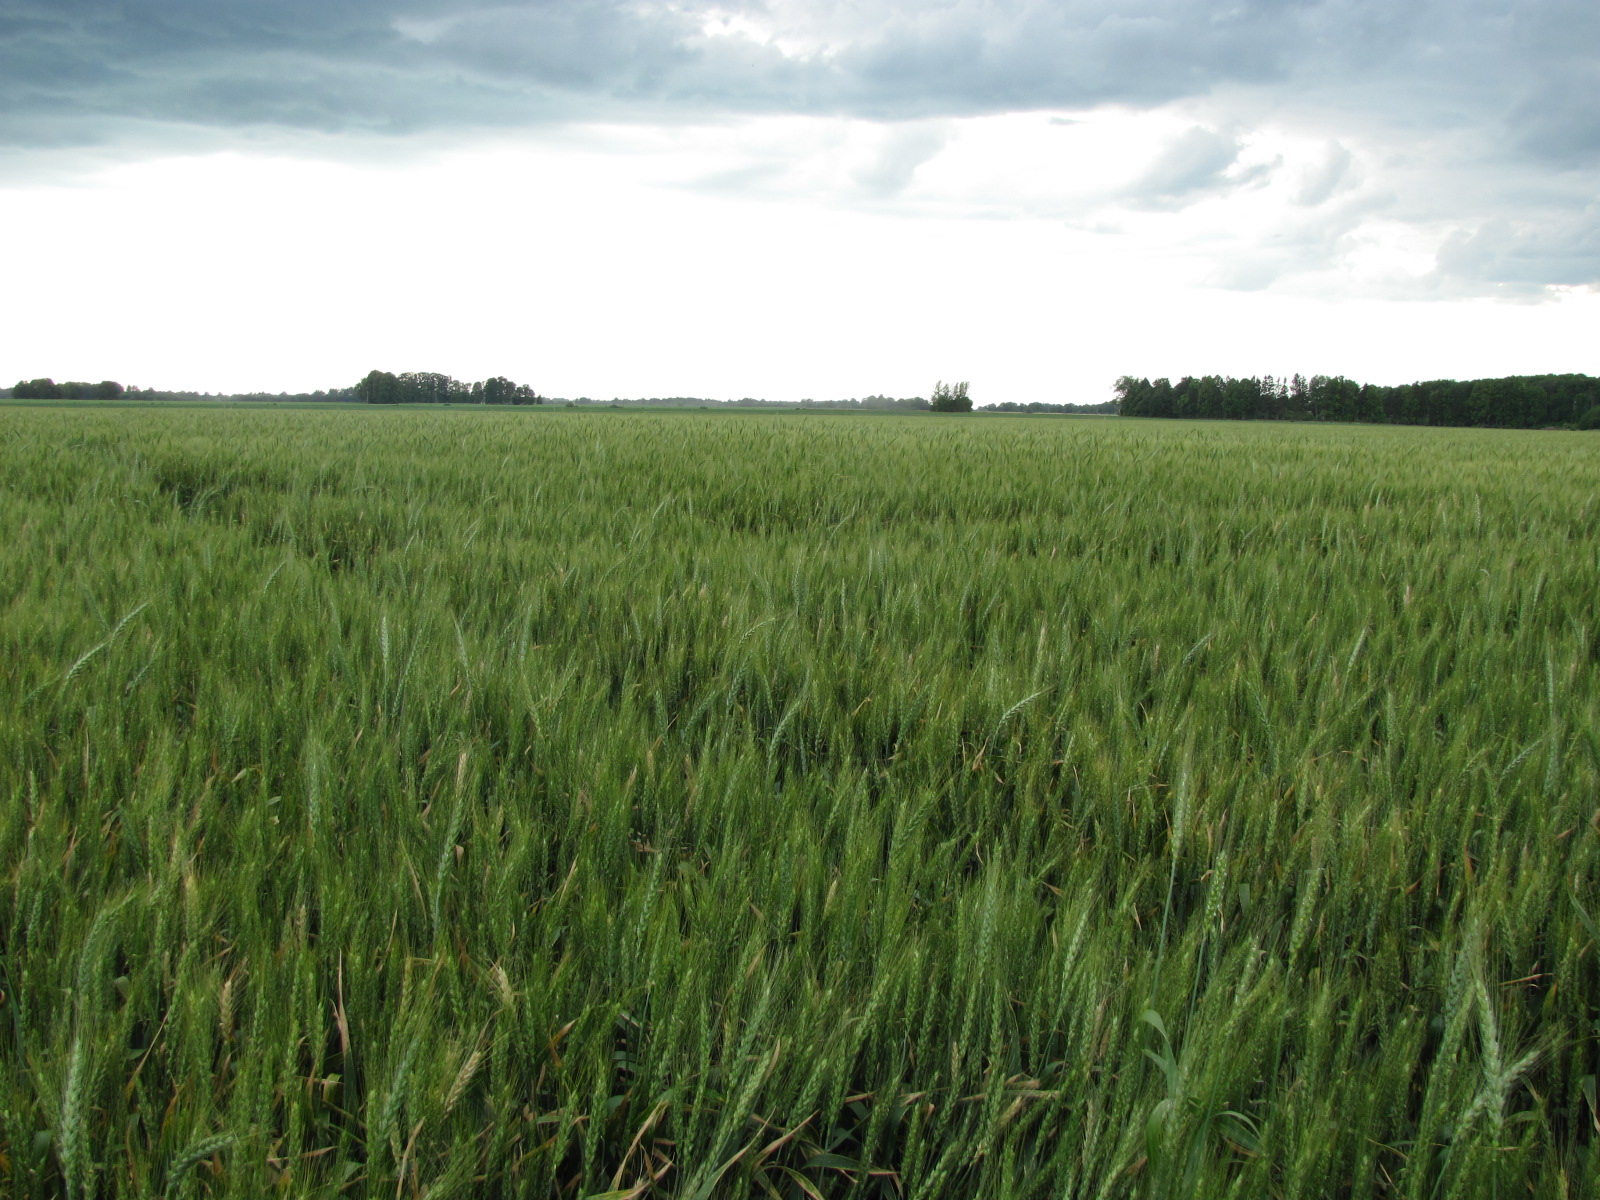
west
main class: Cropland
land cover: Triticale
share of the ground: > 75 %
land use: Agriculture (excluding fallow land and kitchen gardens)
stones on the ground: < 10 %
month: June
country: LV
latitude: 56.4229
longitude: 23.9791
